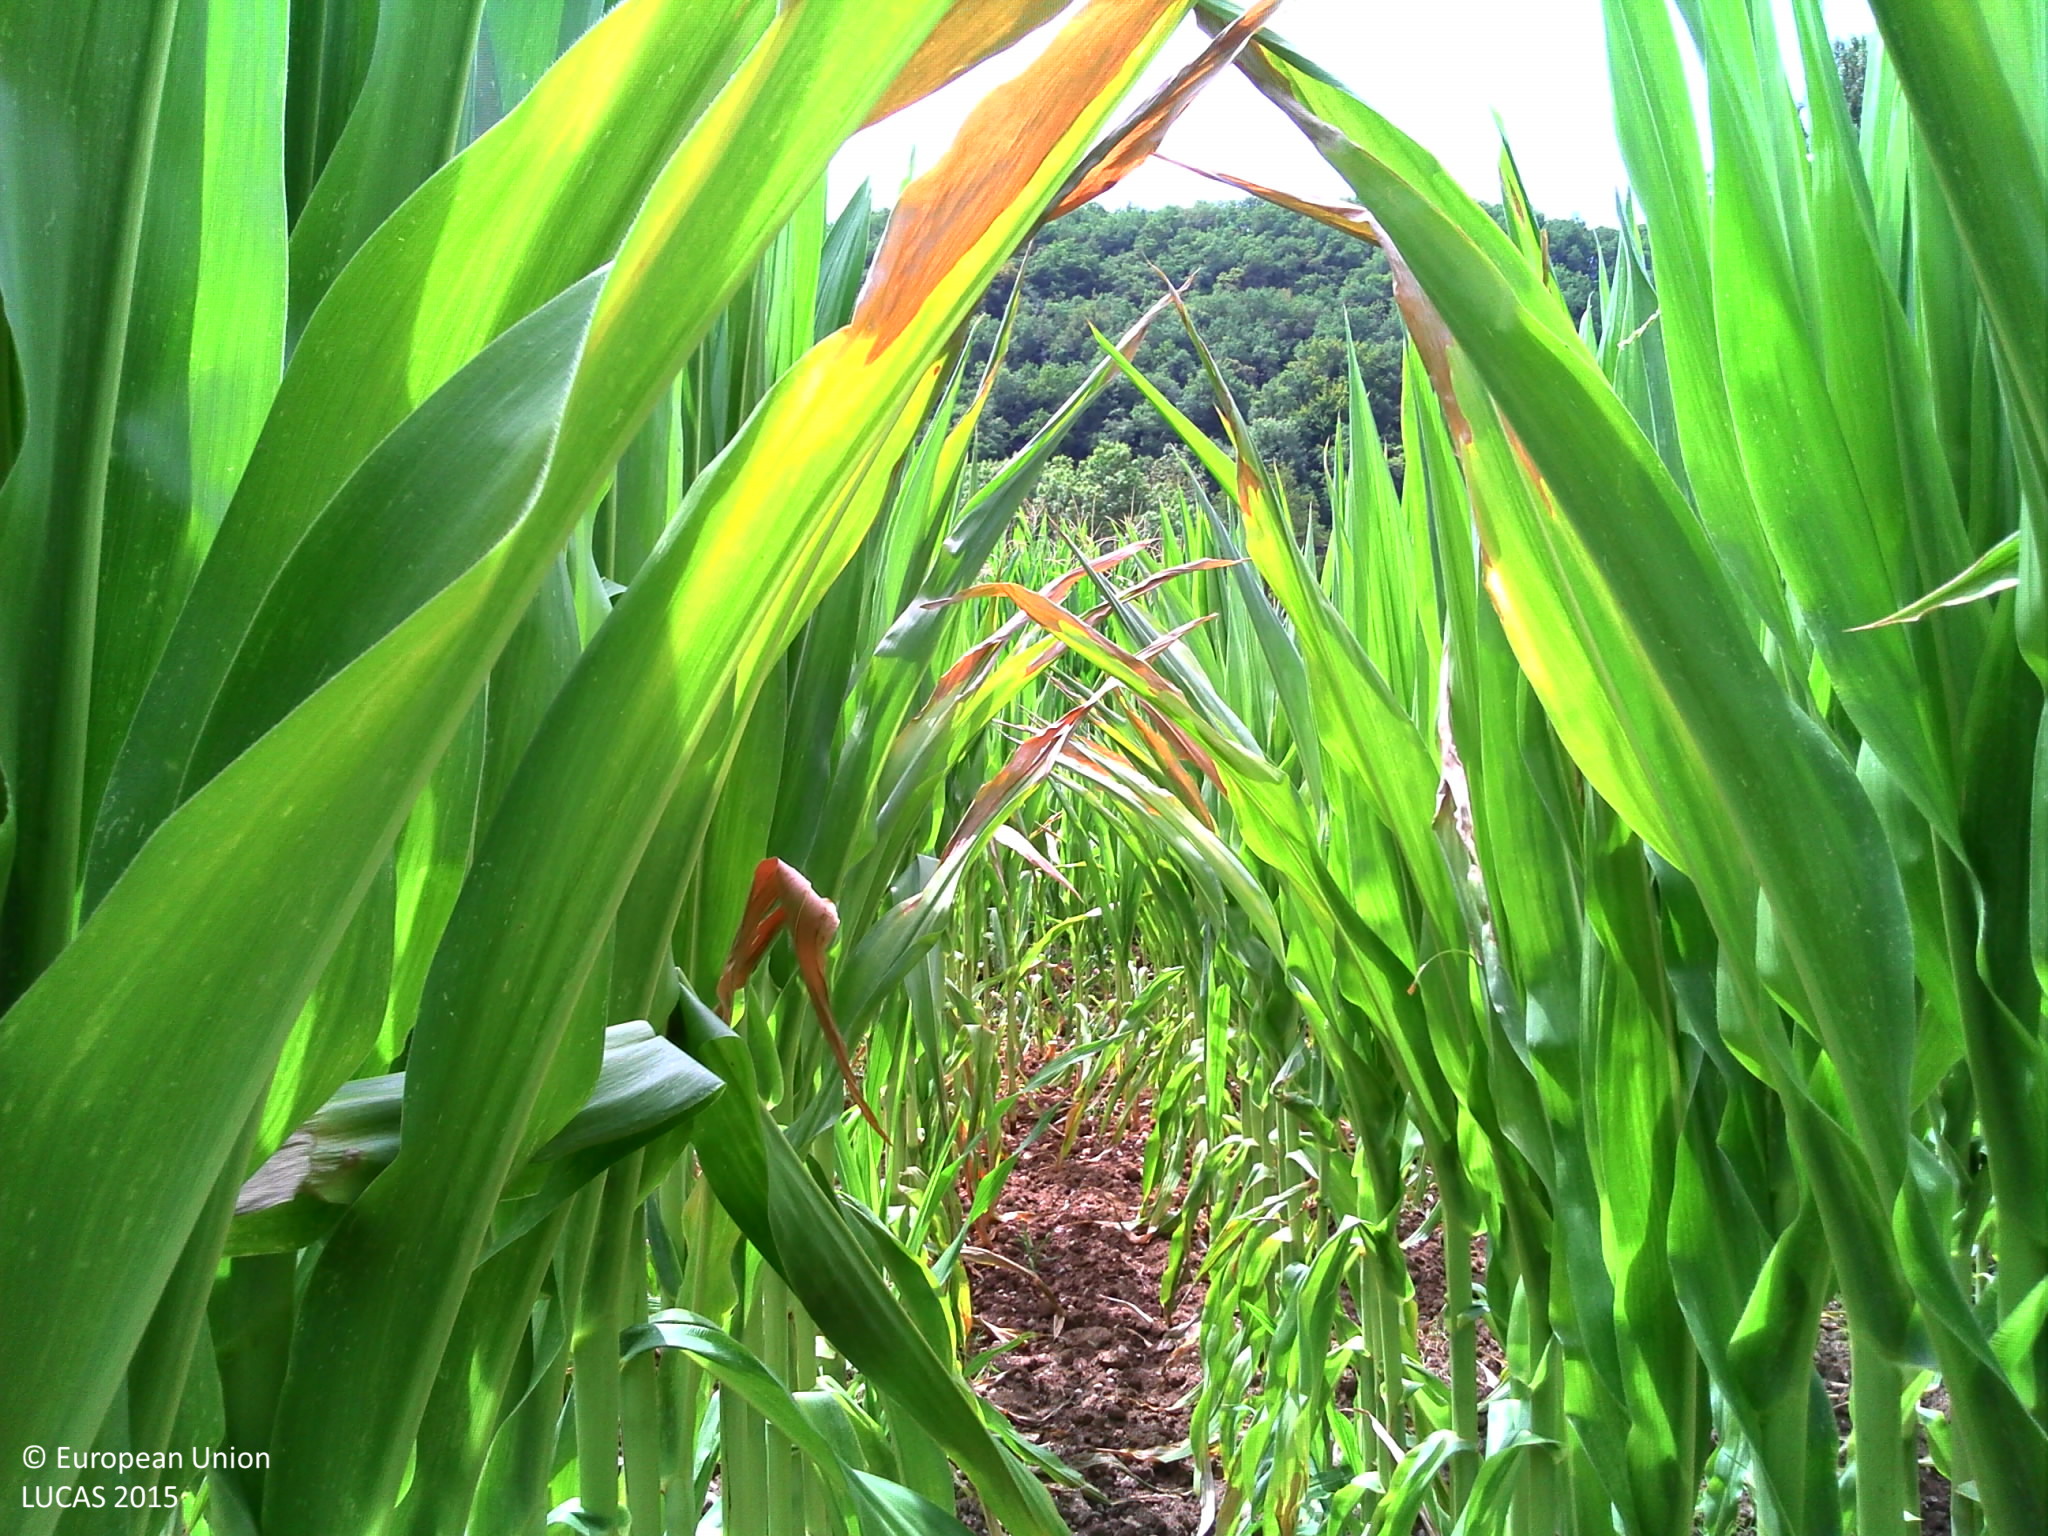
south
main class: Cropland
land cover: Maize
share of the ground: > 75 %
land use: Agriculture (excluding fallow land and kitchen gardens)
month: July
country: FR
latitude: 44.8520
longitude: 0.8443
